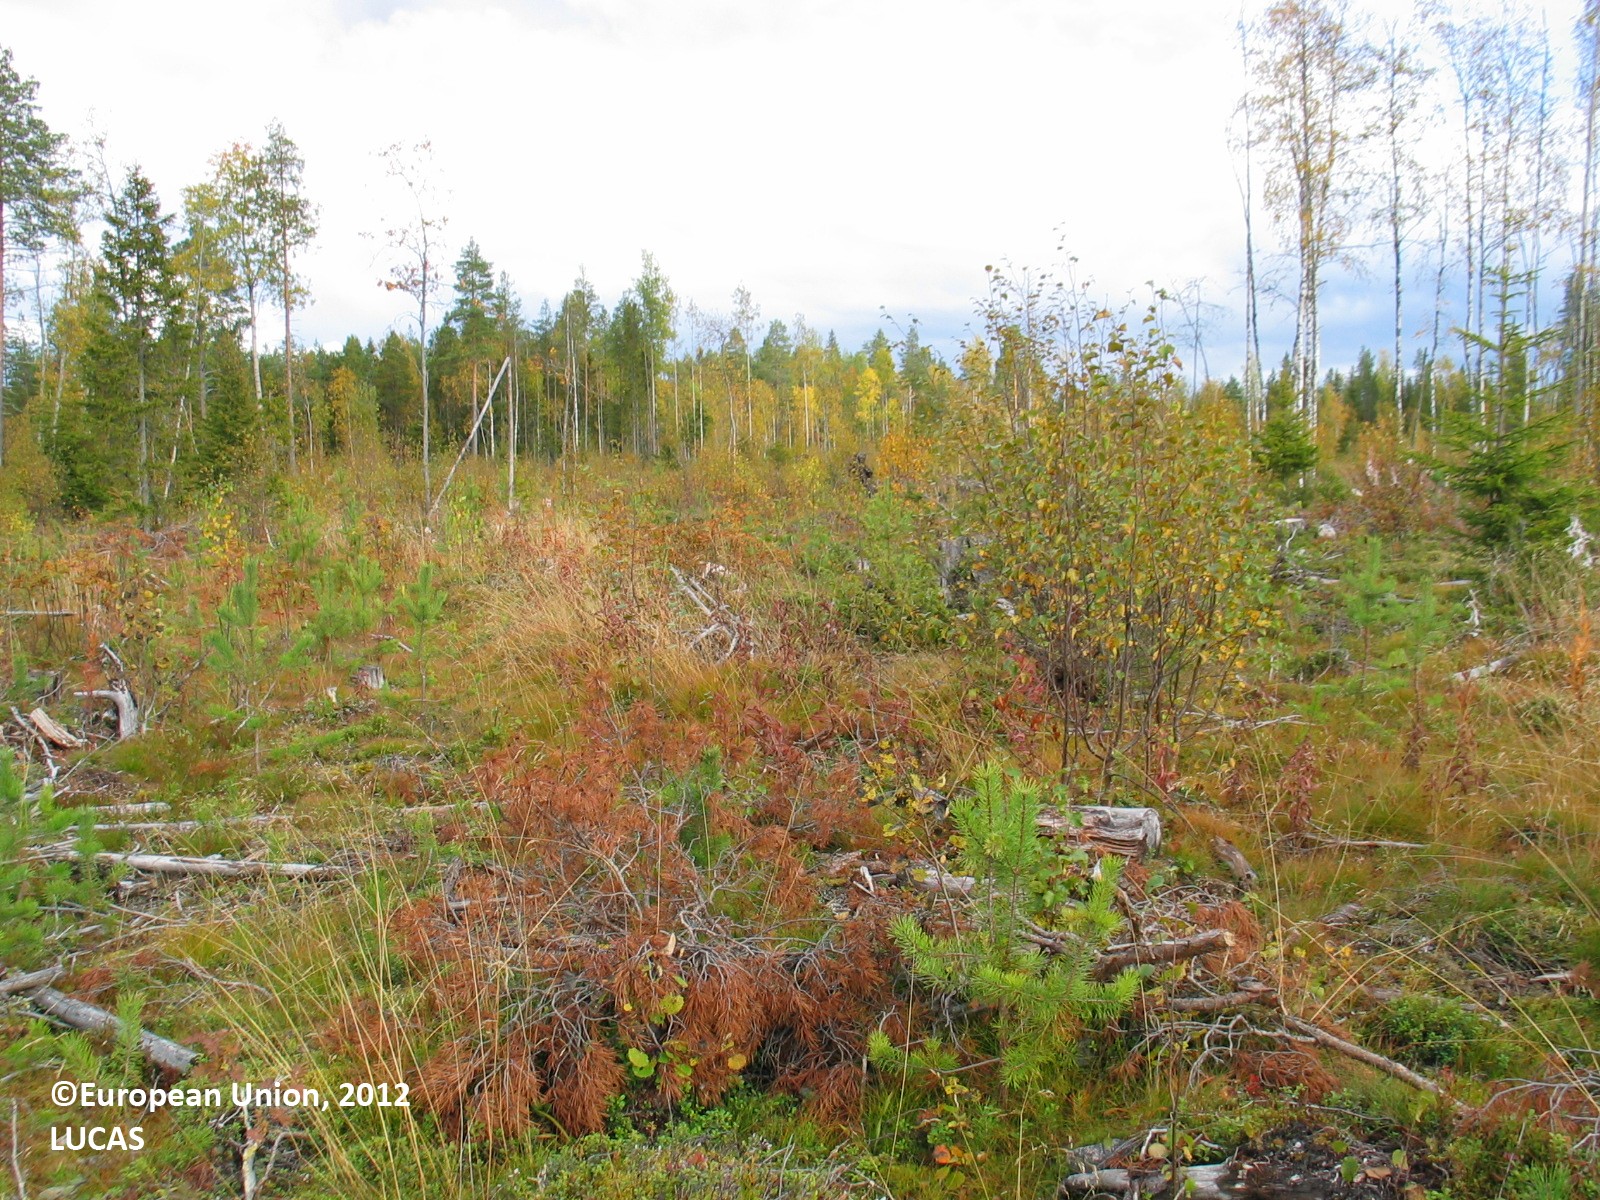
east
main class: Woodland
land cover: Other mixed woodland
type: boreal forest
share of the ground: 25 - 50 %
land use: Forestry
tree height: < 5 m
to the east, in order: Other mixed woodland; Pine dominated mixed woodland; Ditches and canals; Pine dominated mixed woodland
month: September
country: FI
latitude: 65.5617
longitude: 25.6110
